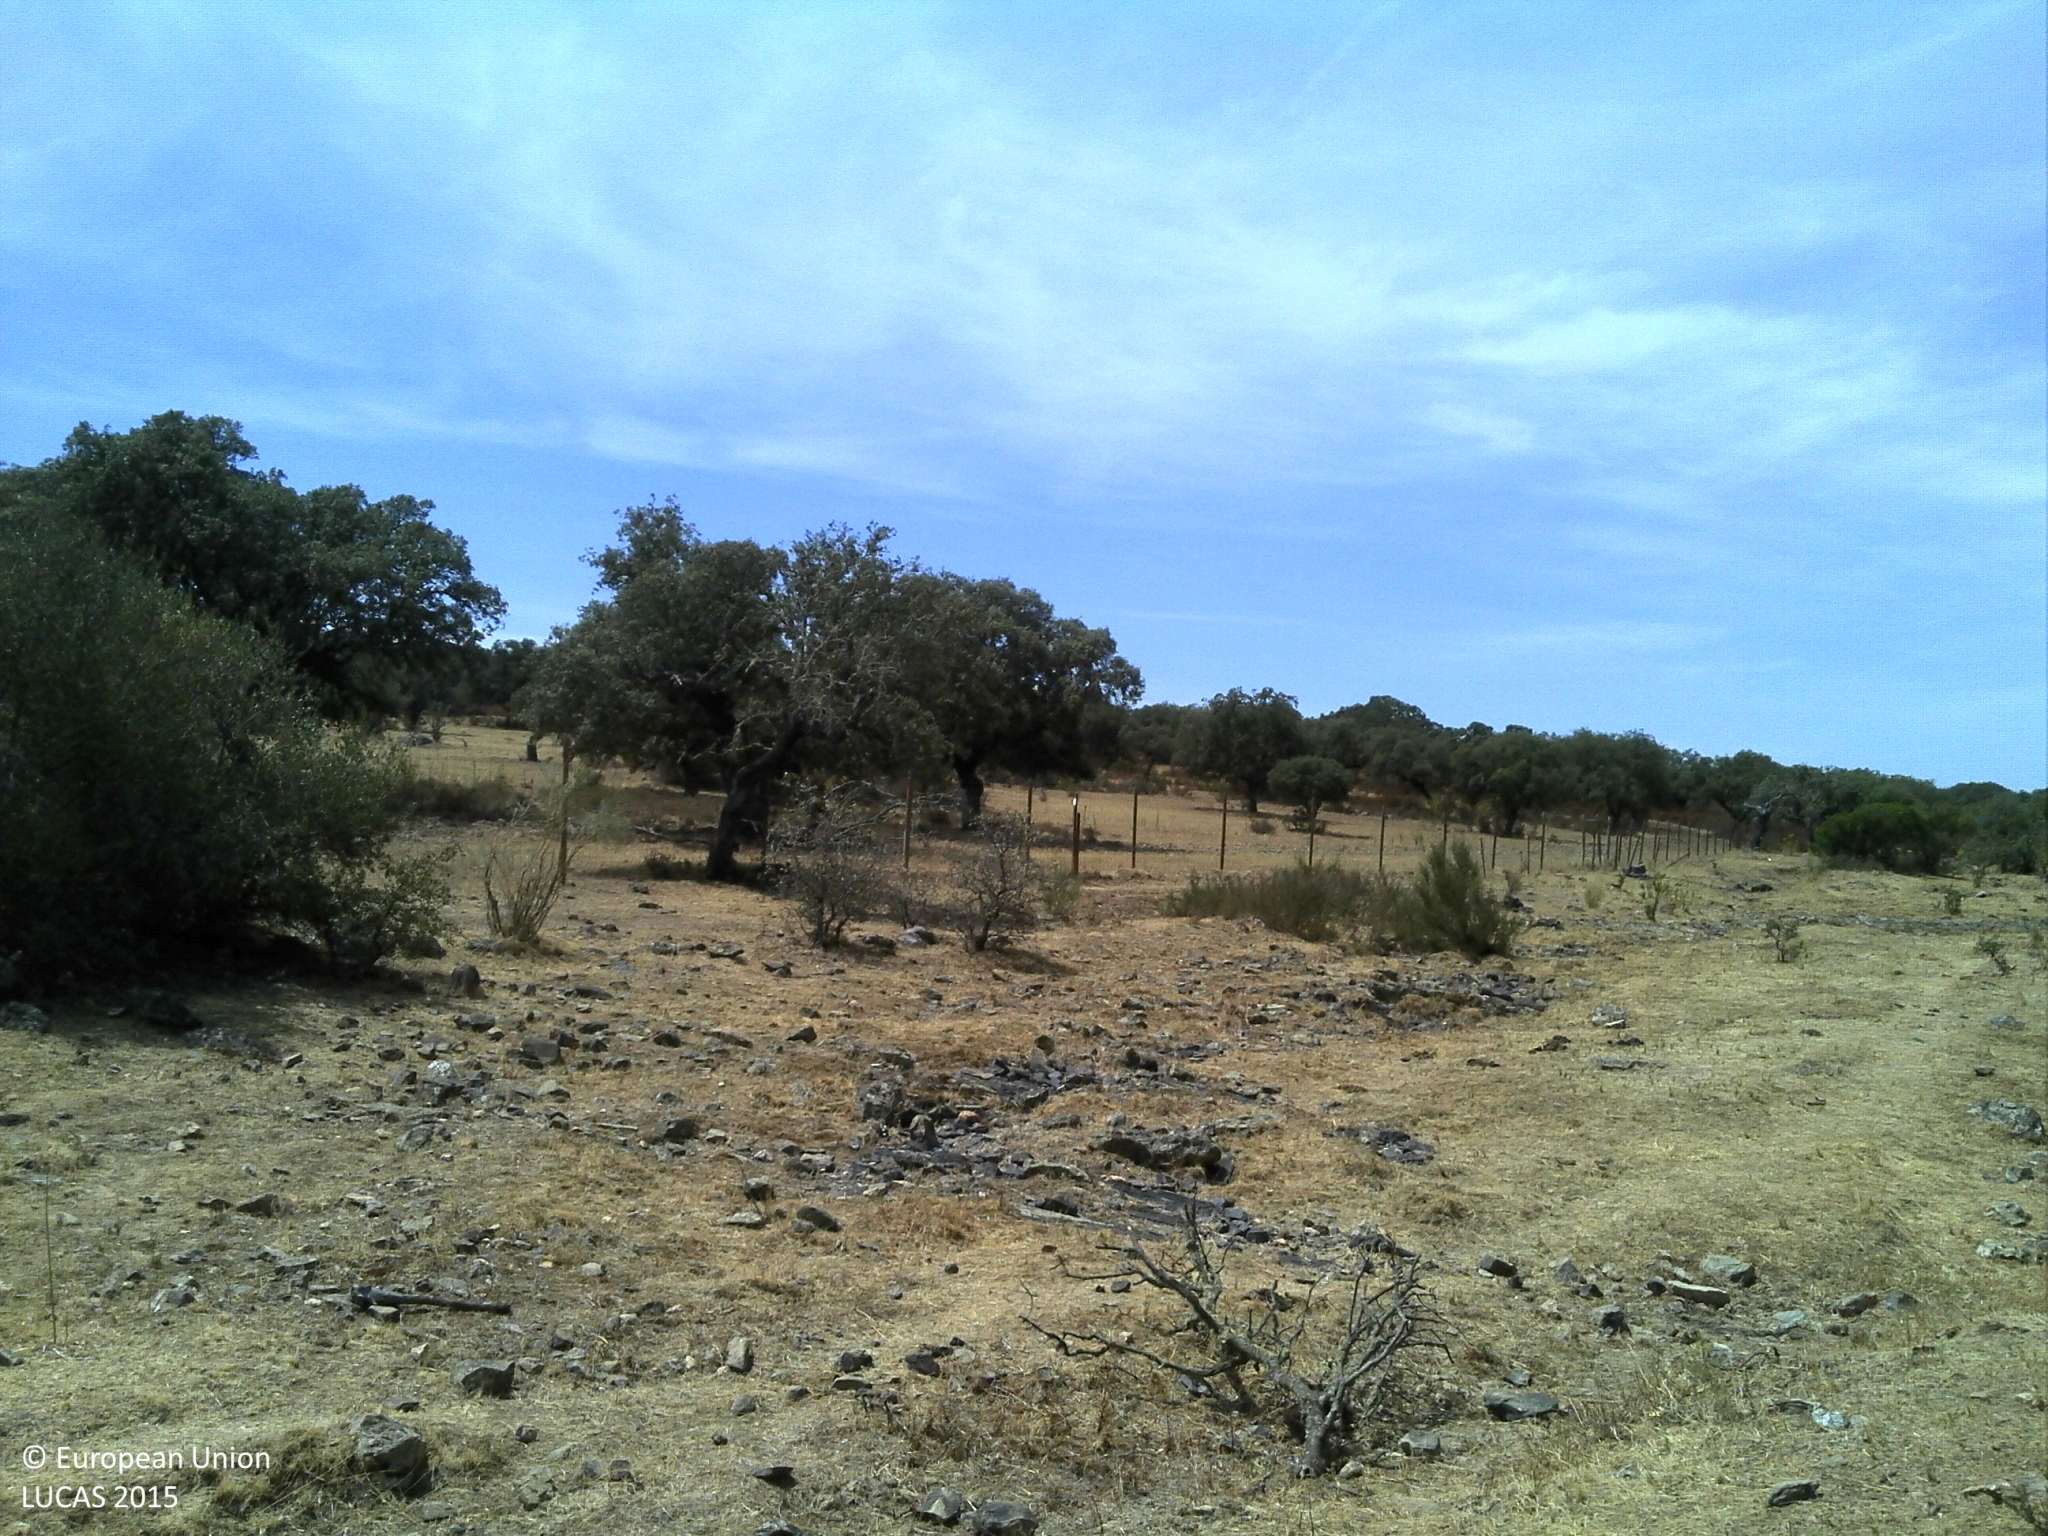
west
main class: Woodland
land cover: Broadleaved woodland
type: broadleaved evergreen forest
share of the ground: 10 - 25 %
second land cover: Grassland without tree/shrub cover
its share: 10 - 25 %
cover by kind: unconsolidated bare surface 75 %, broadleaved forest trees 10 %, herbaceous plants 10 %, shrubs 5 %
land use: Forestry
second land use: Agriculture (excluding fallow land and kitchen gardens)
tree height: > 5 m
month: July
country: PT
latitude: 38.3215
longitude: -7.4443
